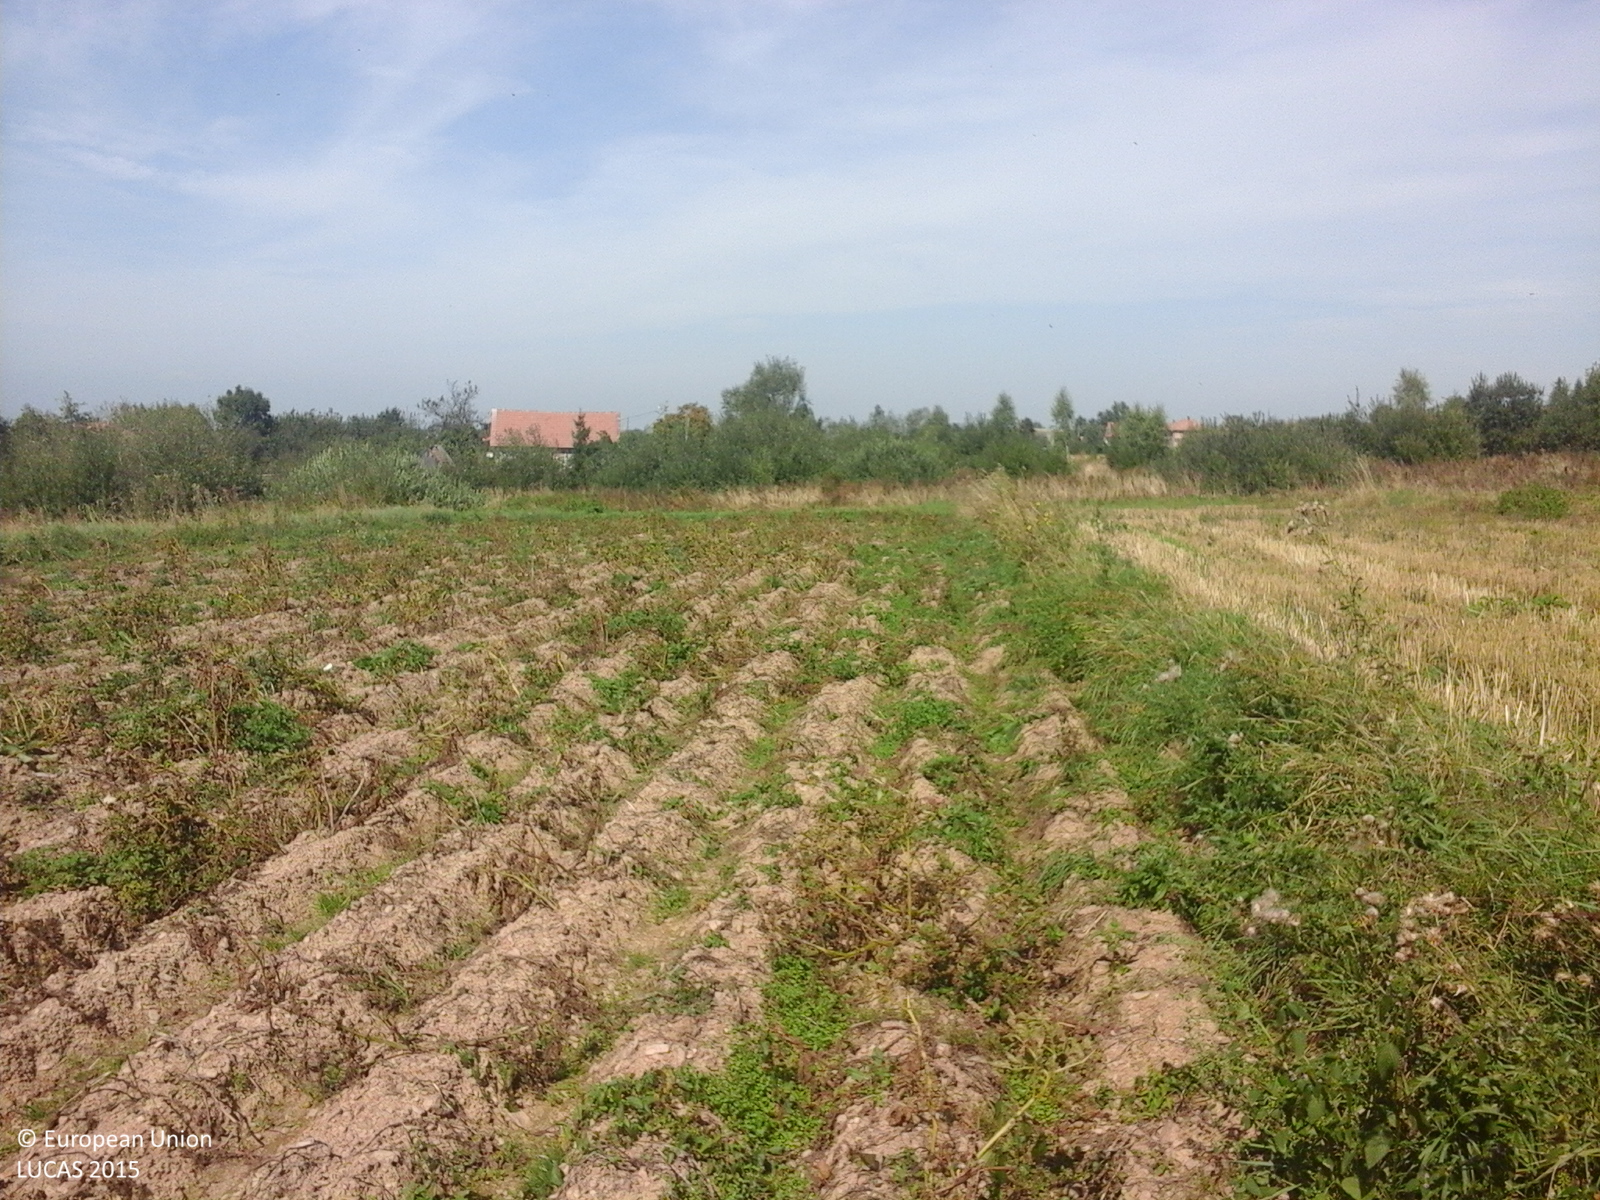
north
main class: Cropland
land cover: Potatoes
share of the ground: > 75 %
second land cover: Spontaneously vegetated surfaces
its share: 25 - 50 %
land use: Agriculture (excluding fallow land and kitchen gardens)
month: September
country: RO
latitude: 46.7516
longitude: 23.1940
